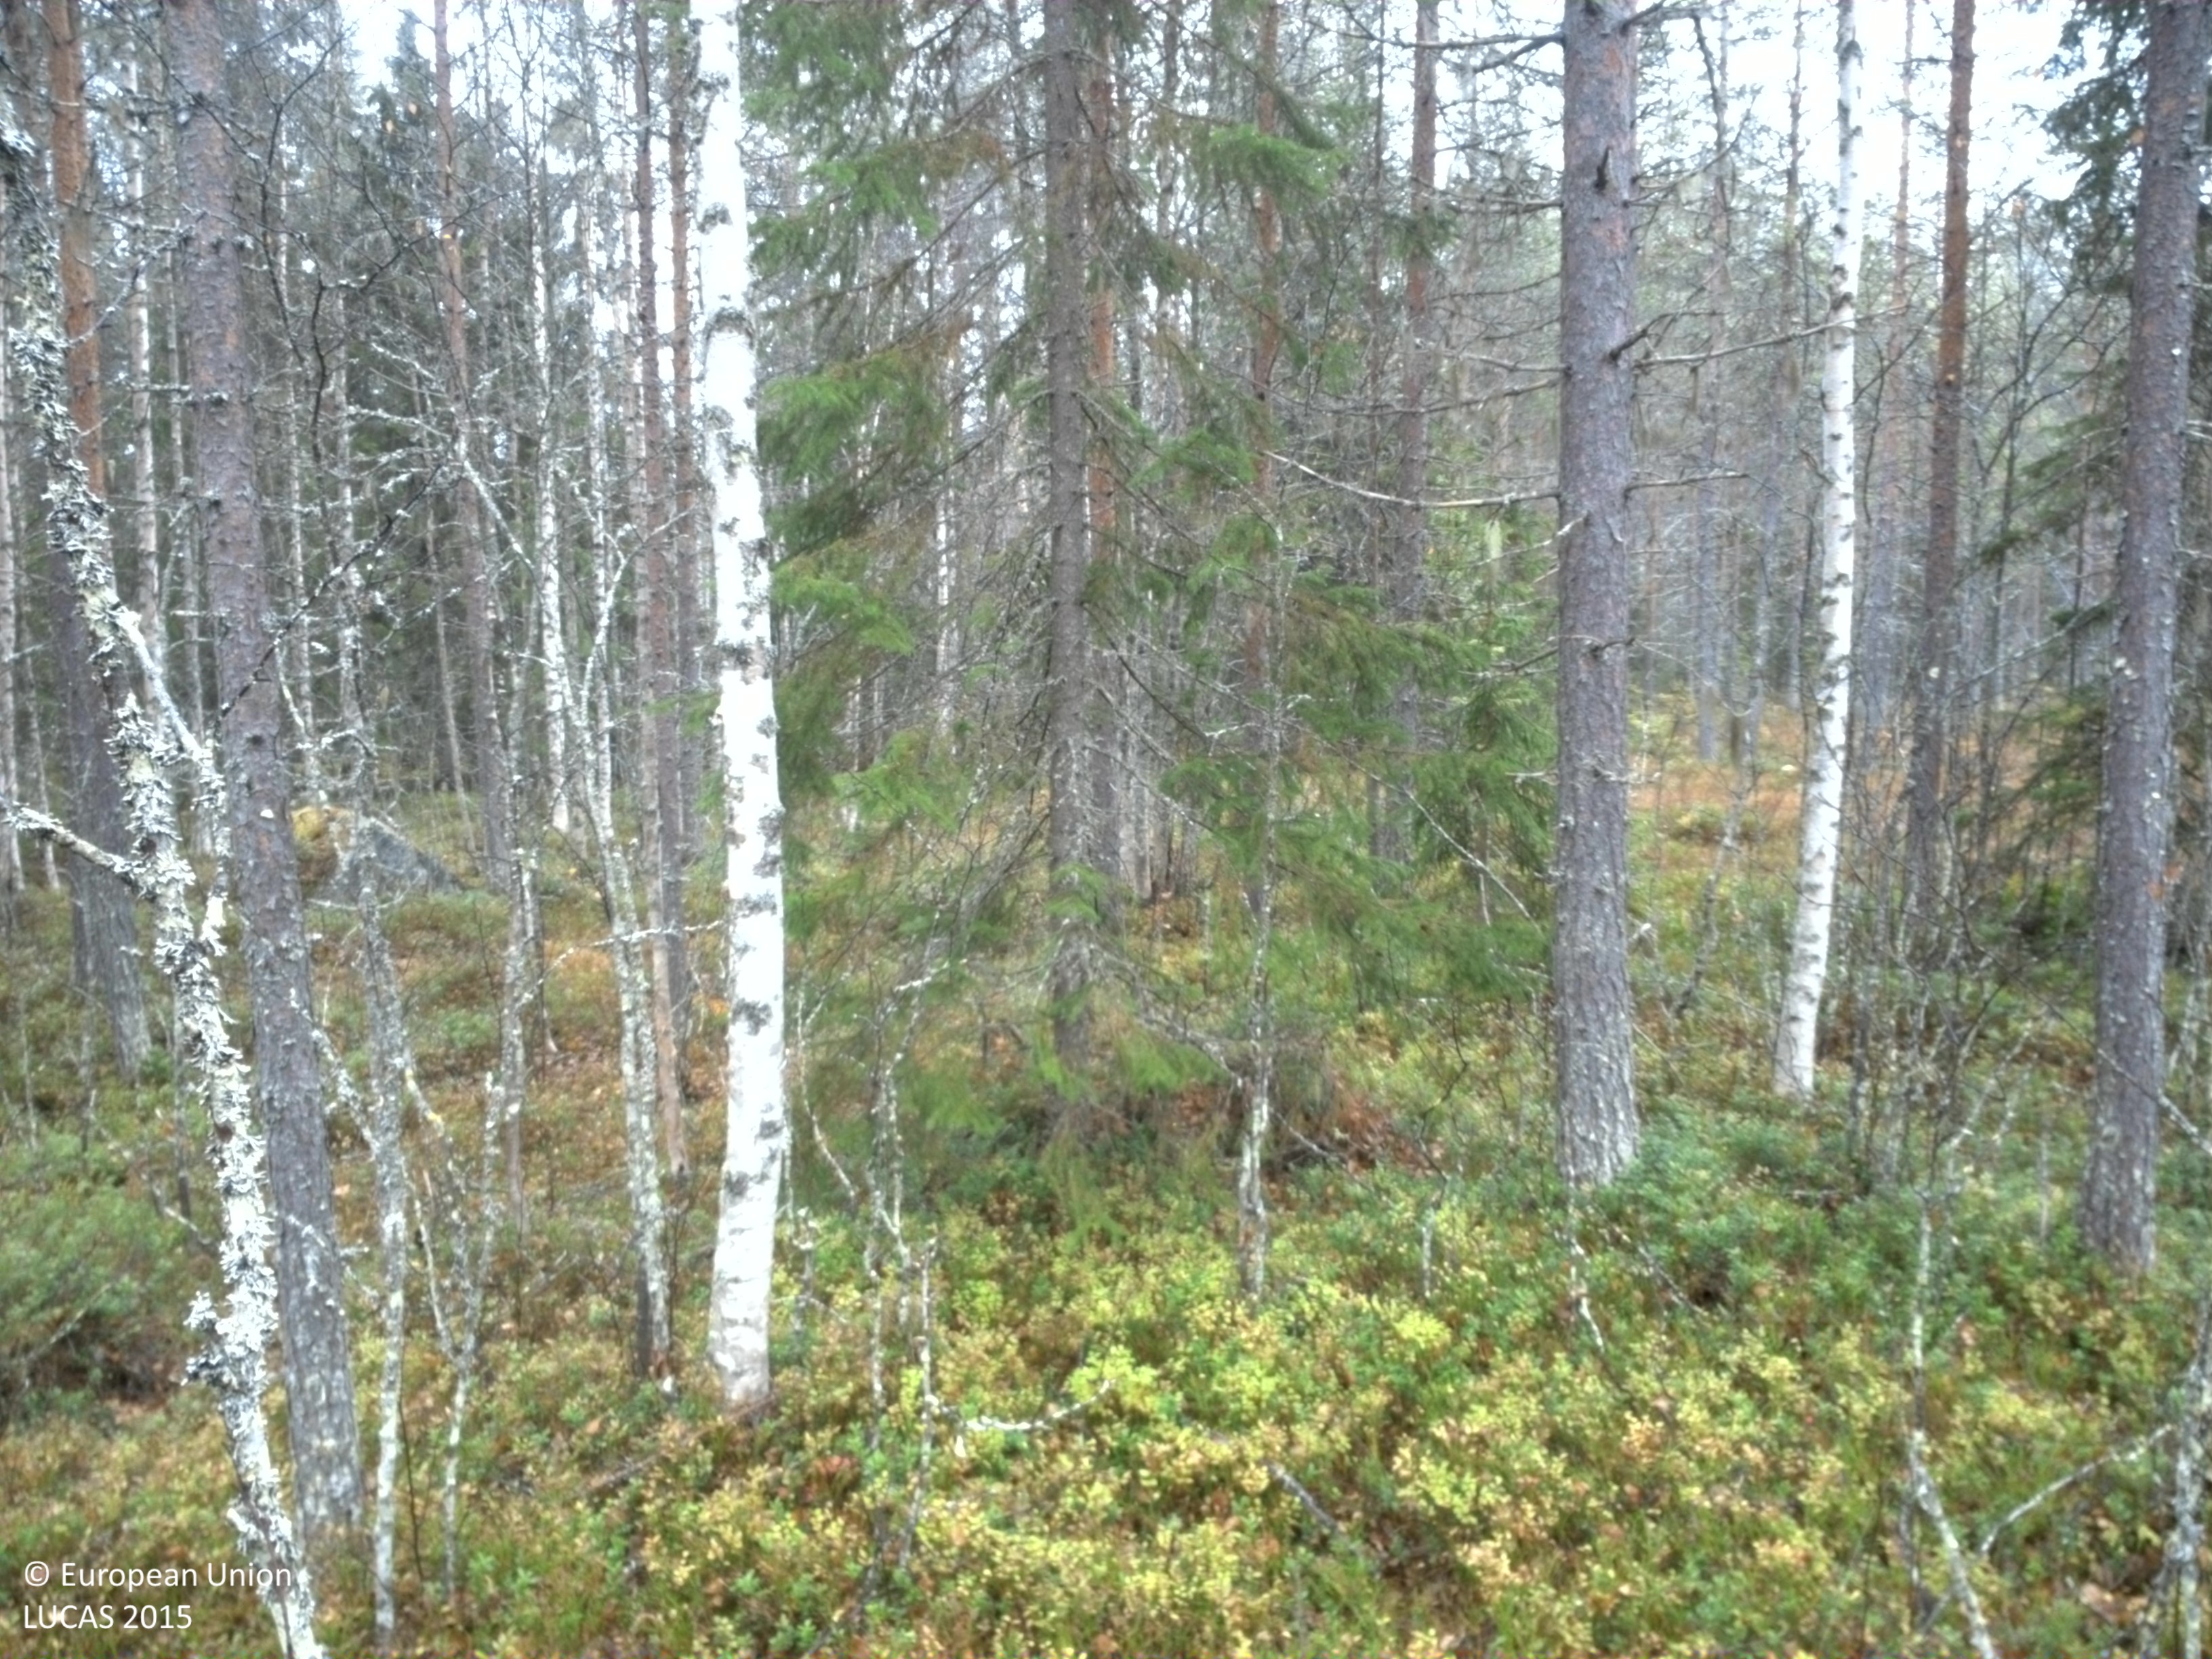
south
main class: Woodland
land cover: Pine dominated mixed woodland
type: boreal forest
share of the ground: 25 - 50 %
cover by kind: shrubs 35 %, coniferous forest trees 25 %, lichens and mosses 20 %, broadleaved forest trees 15 %, herbaceous plants 5 %
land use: Forestry
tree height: > 5 m
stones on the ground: < 10 %
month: October
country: SE
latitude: 64.4713
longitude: 16.7682
